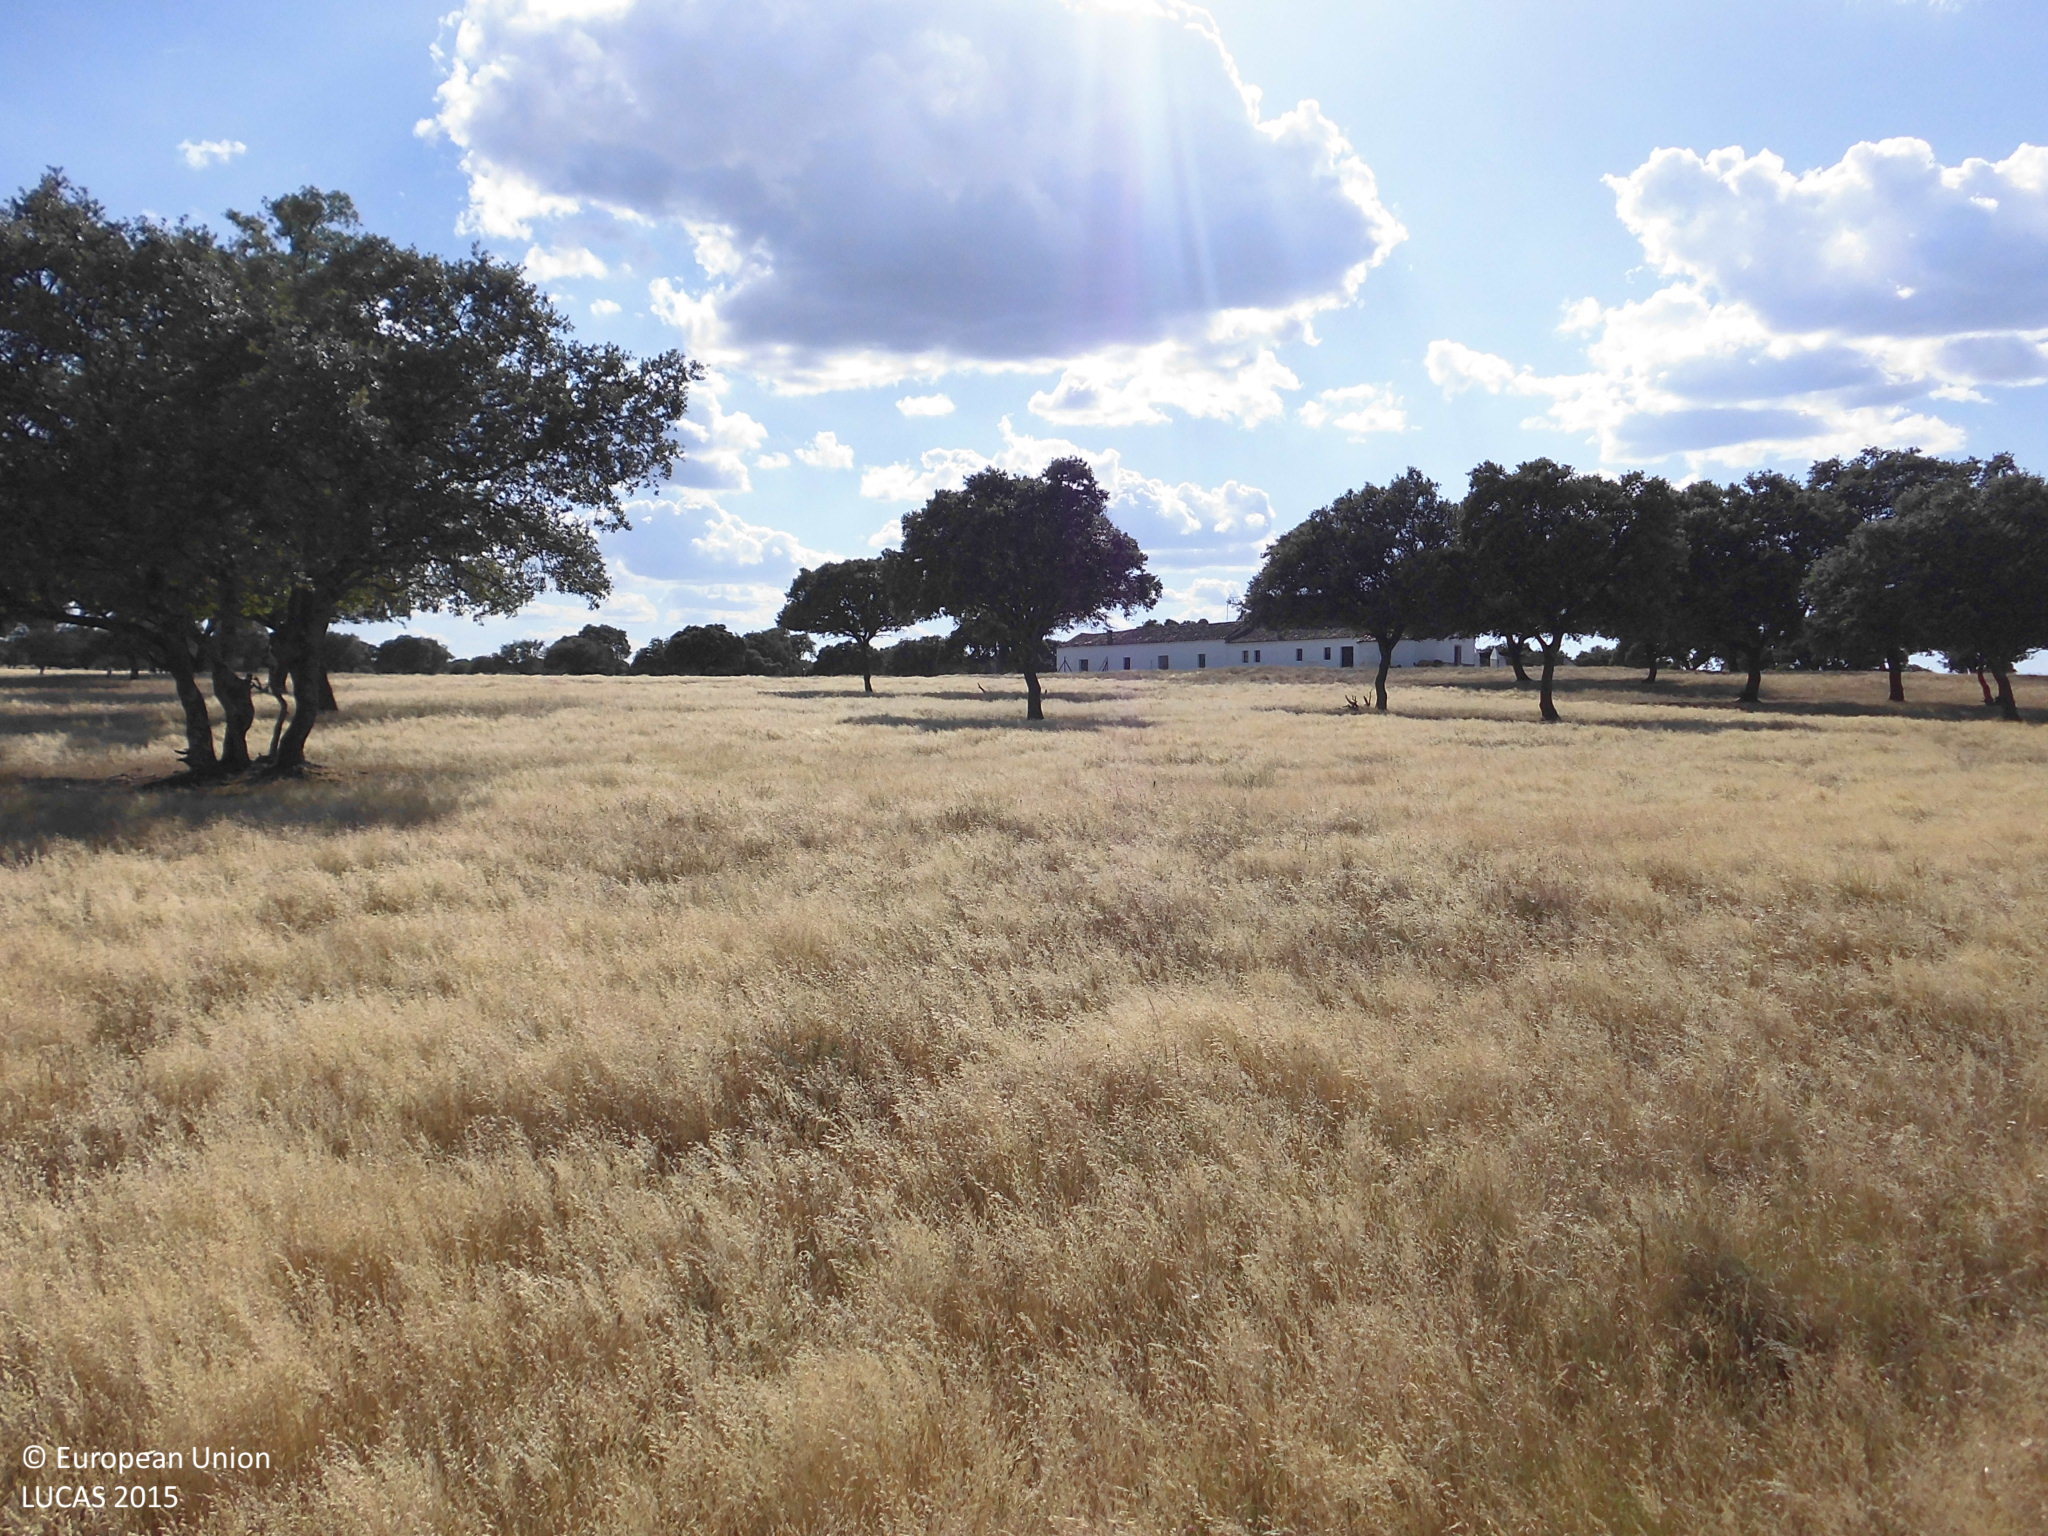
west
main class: Grassland
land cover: Grassland with sparse tree/shrub cover
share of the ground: > 75 %
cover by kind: herbaceous plants 95 %, broadleaved forest trees 5 %
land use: Agriculture (excluding fallow land and kitchen gardens)
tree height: > 5 m
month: May
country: ES
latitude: 39.9774
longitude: -6.7469
